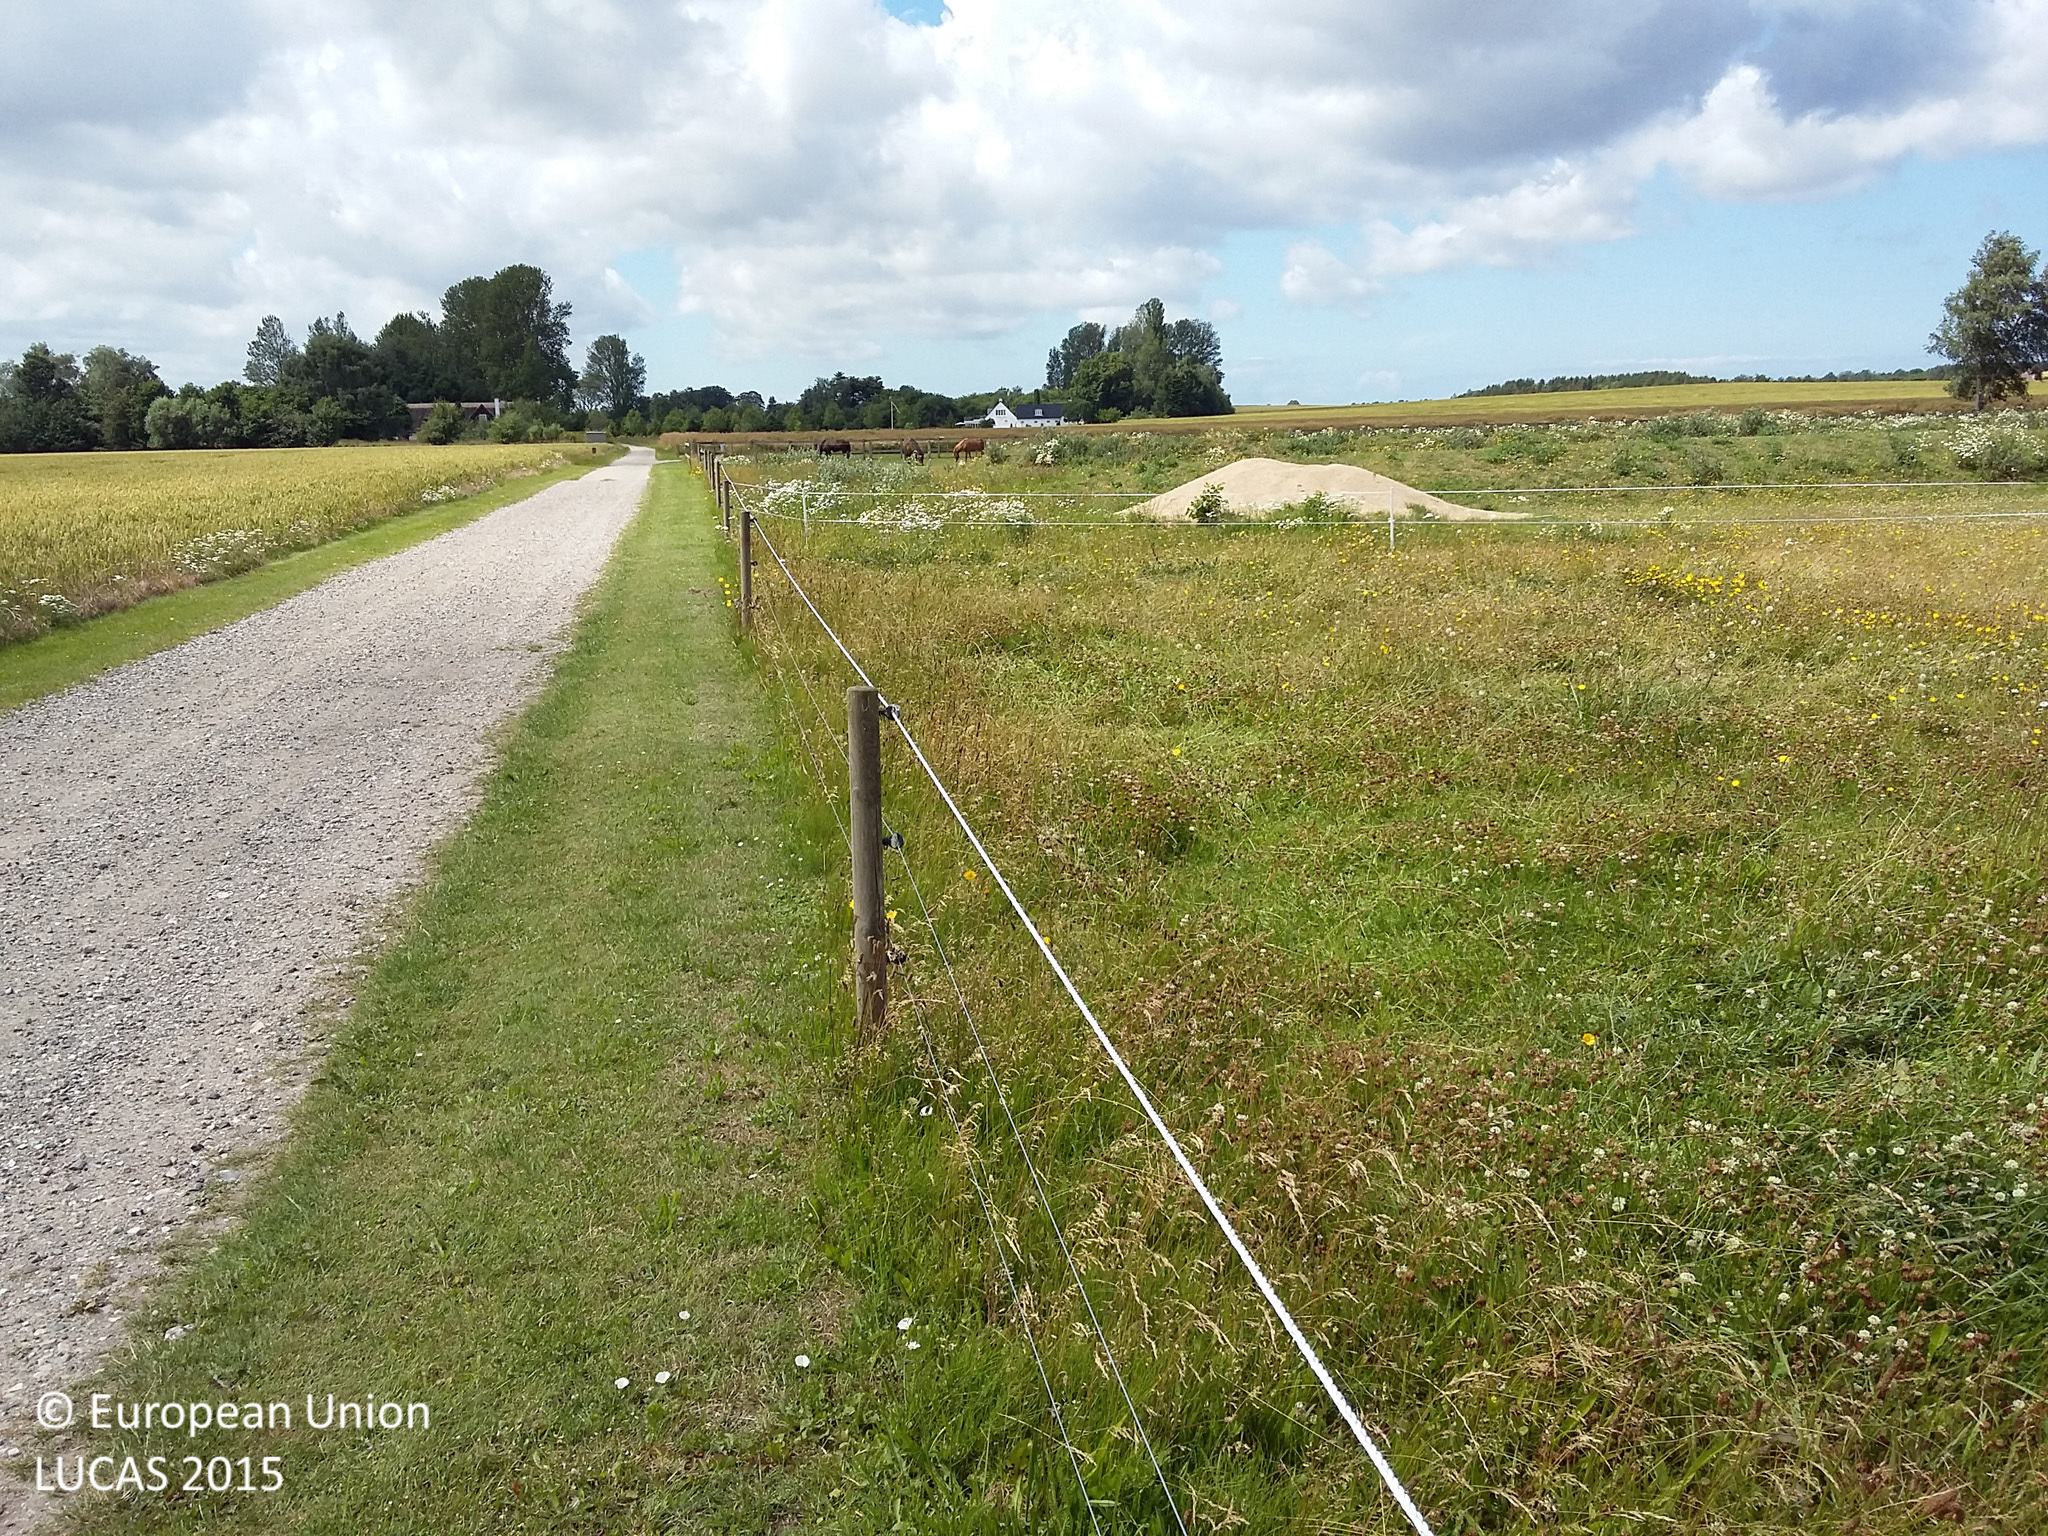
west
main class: Grassland
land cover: Grassland without tree/shrub cover
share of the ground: > 75 %
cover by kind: herbaceous plants 100 %
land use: Agriculture (excluding fallow land and kitchen gardens)
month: July
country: DK
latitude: 55.7625
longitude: 11.7355
